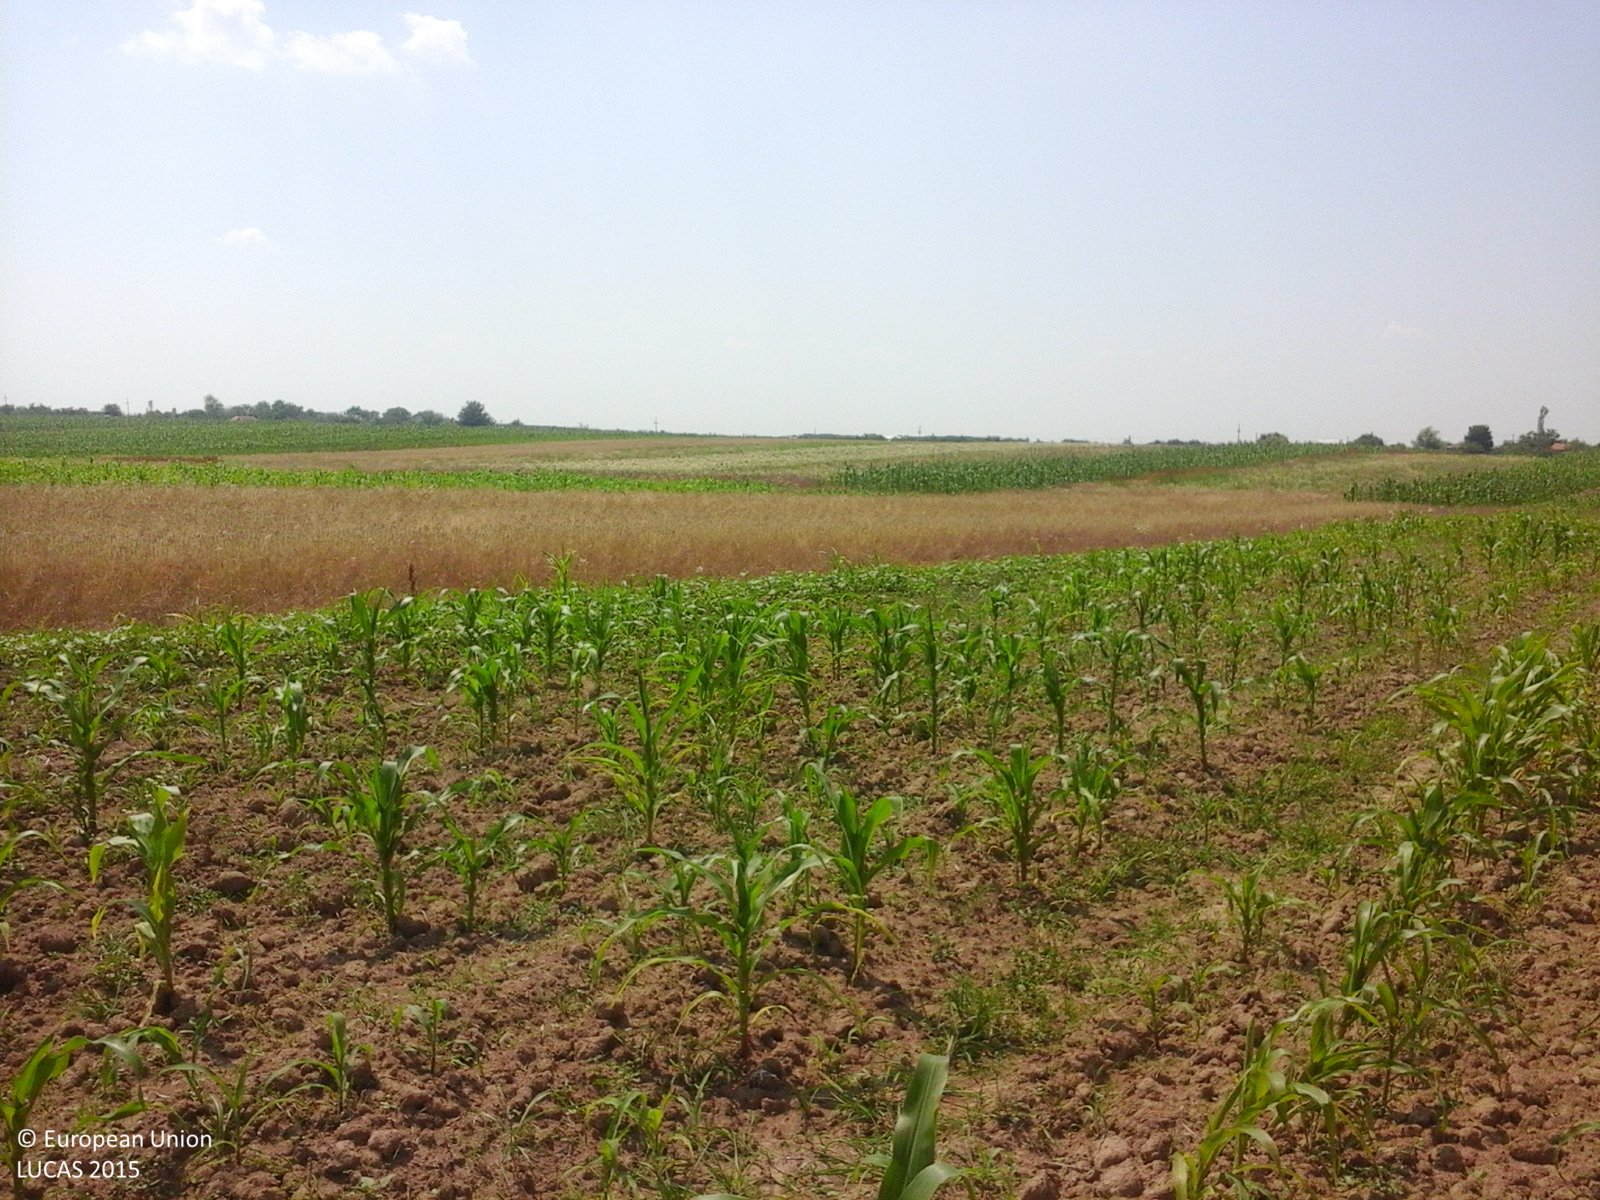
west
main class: Cropland
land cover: Maize
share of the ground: < 10 %
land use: Agriculture (excluding fallow land and kitchen gardens)
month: July
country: RO
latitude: 44.7761
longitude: 24.4661
